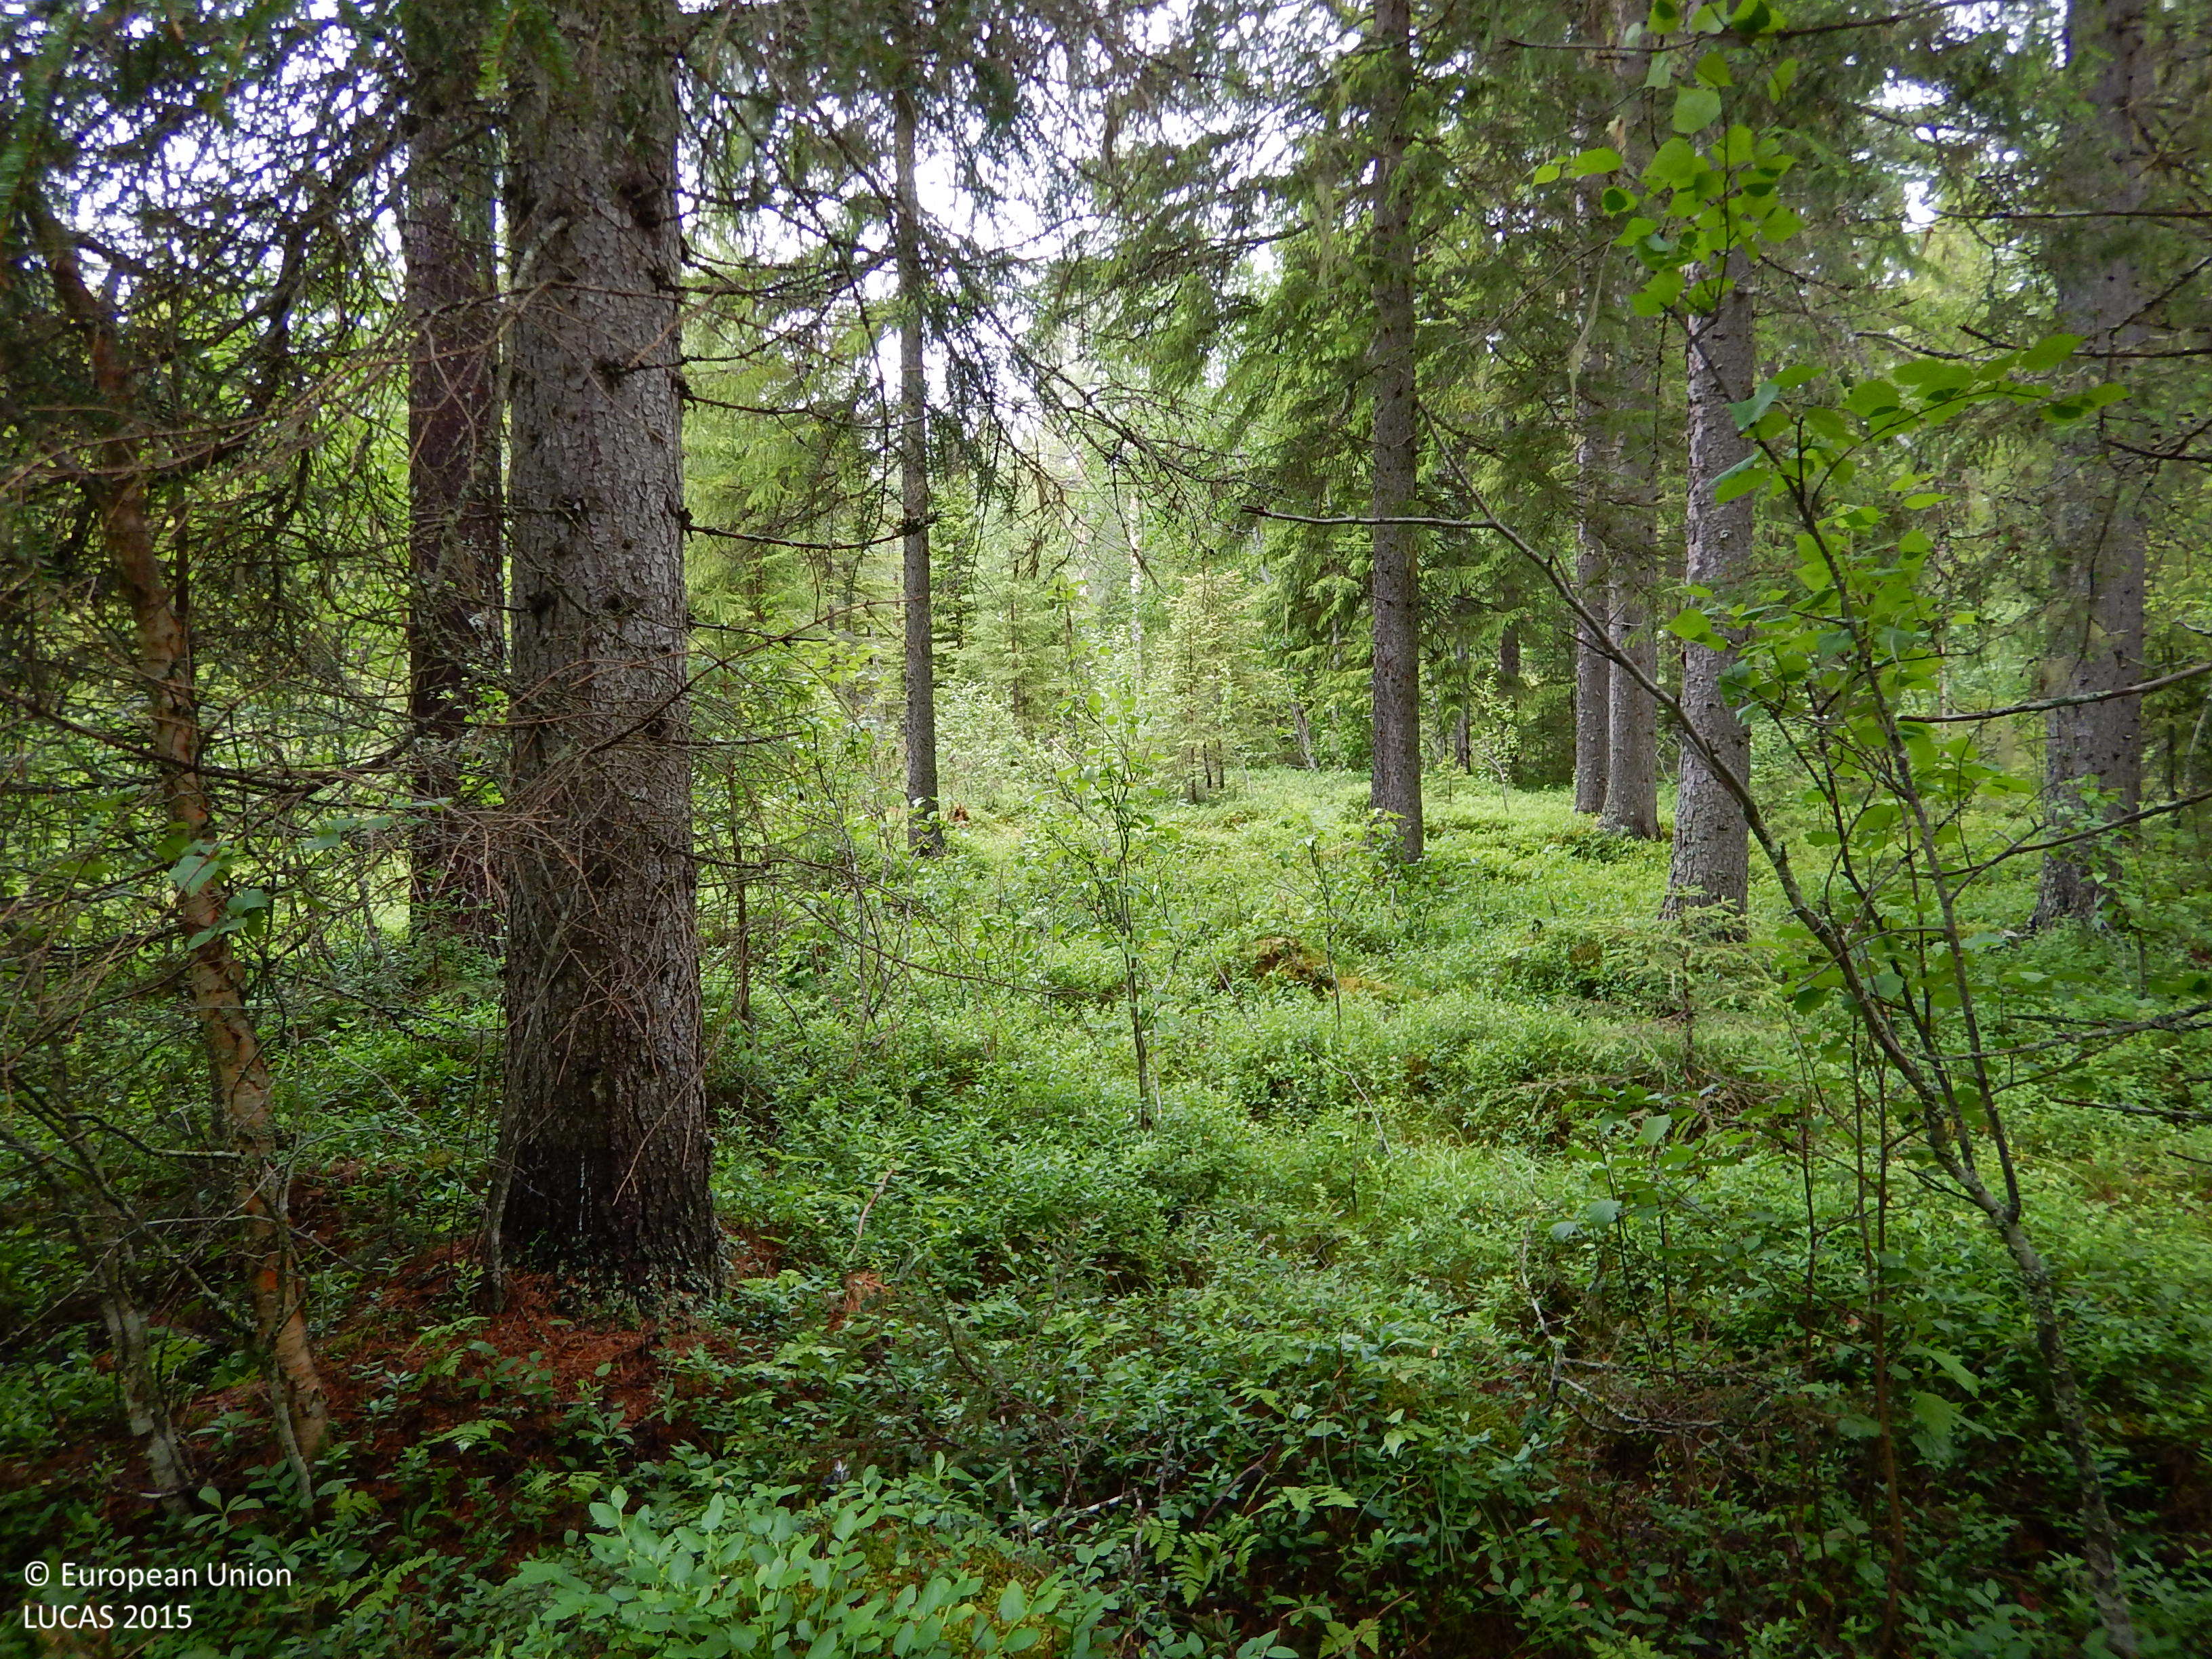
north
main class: Woodland
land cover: Spruce dominated coniferous woodland
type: boreal forest
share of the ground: 50 - 75 %
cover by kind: coniferous forest trees 55 %, shrubs 15 %, broadleaved forest trees 10 %, herbaceous plants 10 %, lichens and mosses 10 %
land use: Forestry
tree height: > 5 m
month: July
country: SE
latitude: 64.7854
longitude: 20.6840
